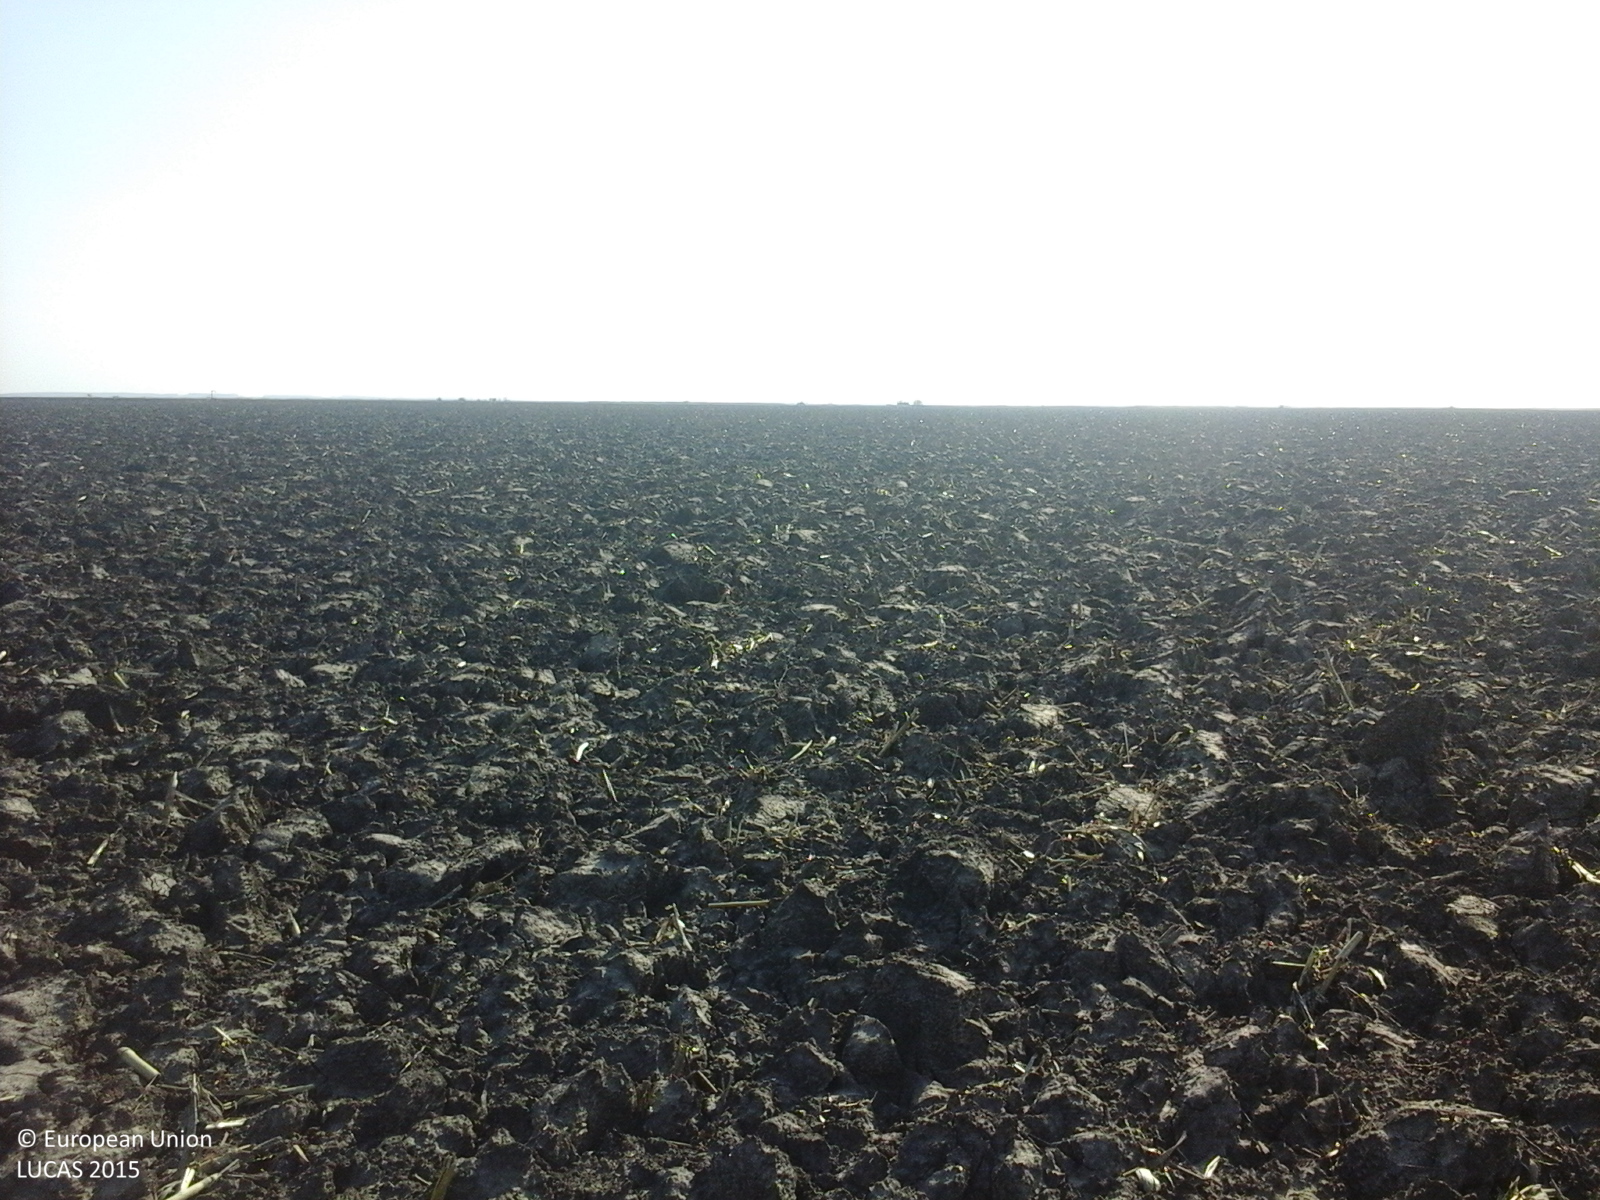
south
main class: Cropland
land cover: Maize
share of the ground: < 10 %
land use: Agriculture (excluding fallow land and kitchen gardens)
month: October
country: RO
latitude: 45.1627
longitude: 26.9921
